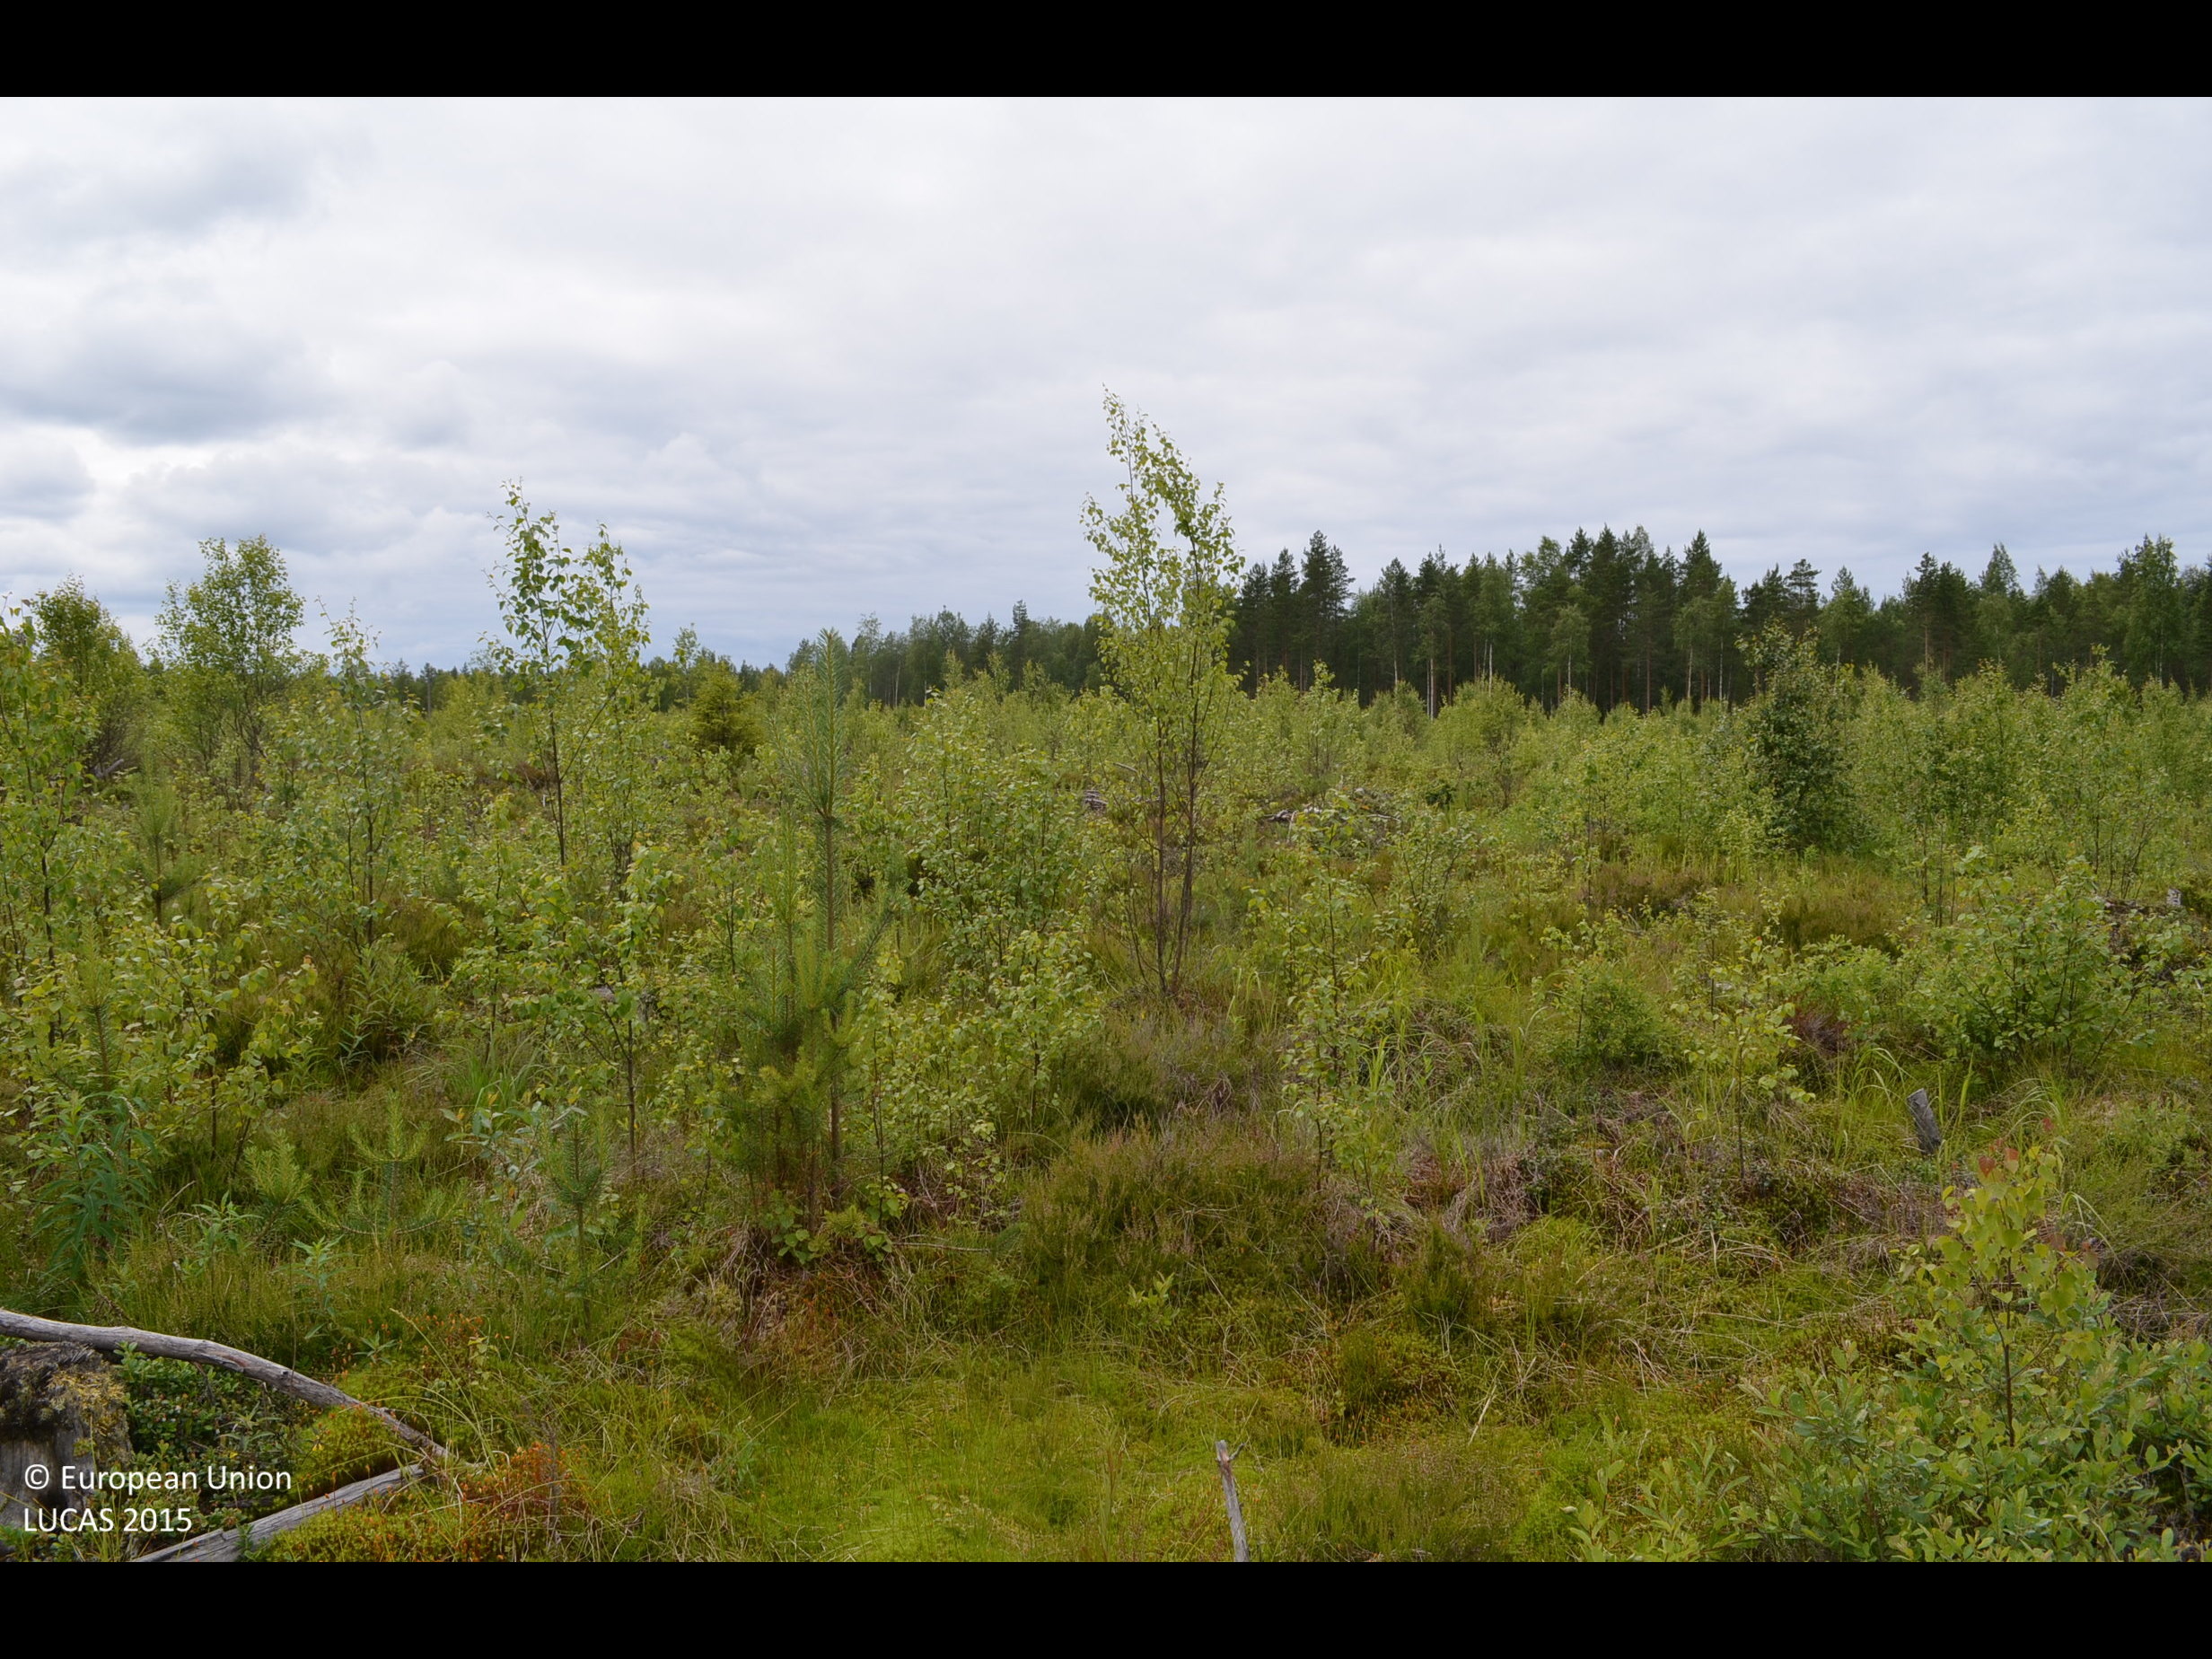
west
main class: Woodland
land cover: Pine dominated mixed woodland
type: boreal forest
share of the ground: 25 - 50 %
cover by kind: shrubs 35 %, broadleaved forest trees 25 %, herbaceous plants 15 %, coniferous forest trees 10 %, lichens and mosses 10 %
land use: Forestry
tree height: < 5 m
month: July
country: FI
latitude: 62.2932
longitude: 23.5107
